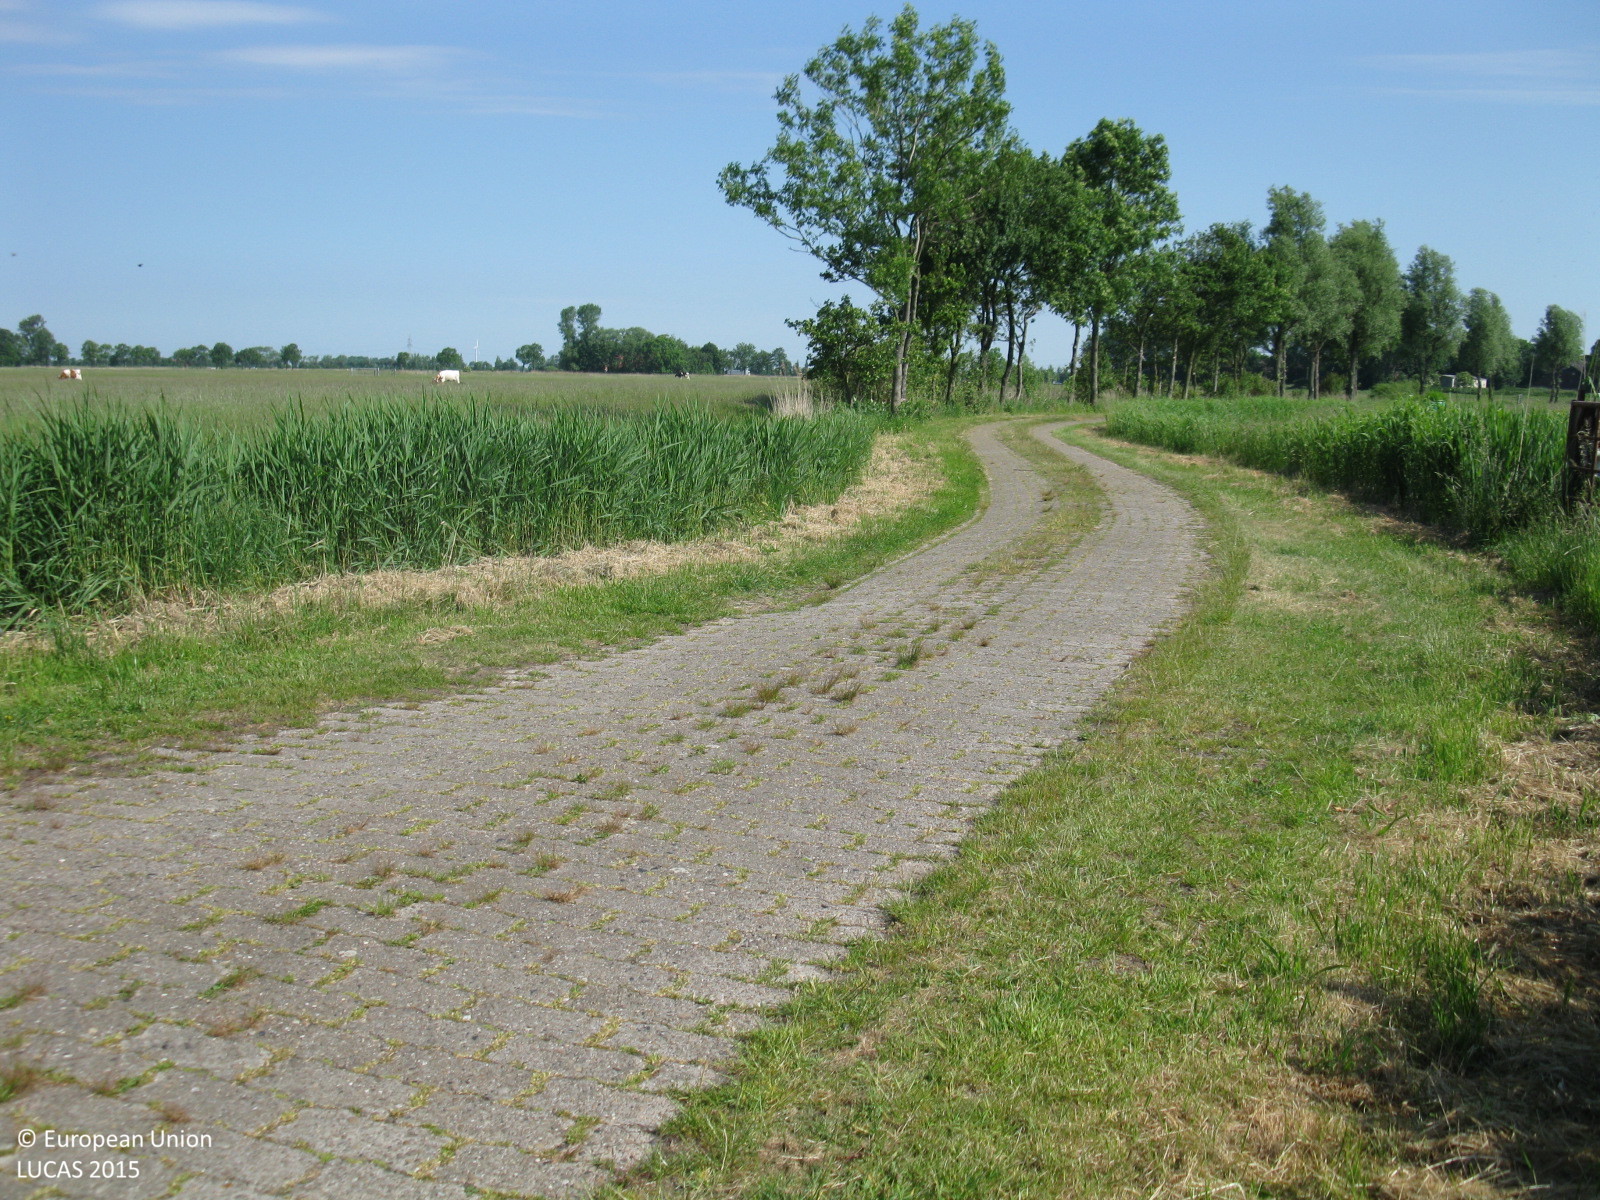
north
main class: Grassland
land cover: Grassland without tree/shrub cover
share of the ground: > 75 %
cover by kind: herbaceous plants 100 %
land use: Agriculture (excluding fallow land and kitchen gardens)
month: June
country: DE
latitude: 53.5186
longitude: 8.5075
